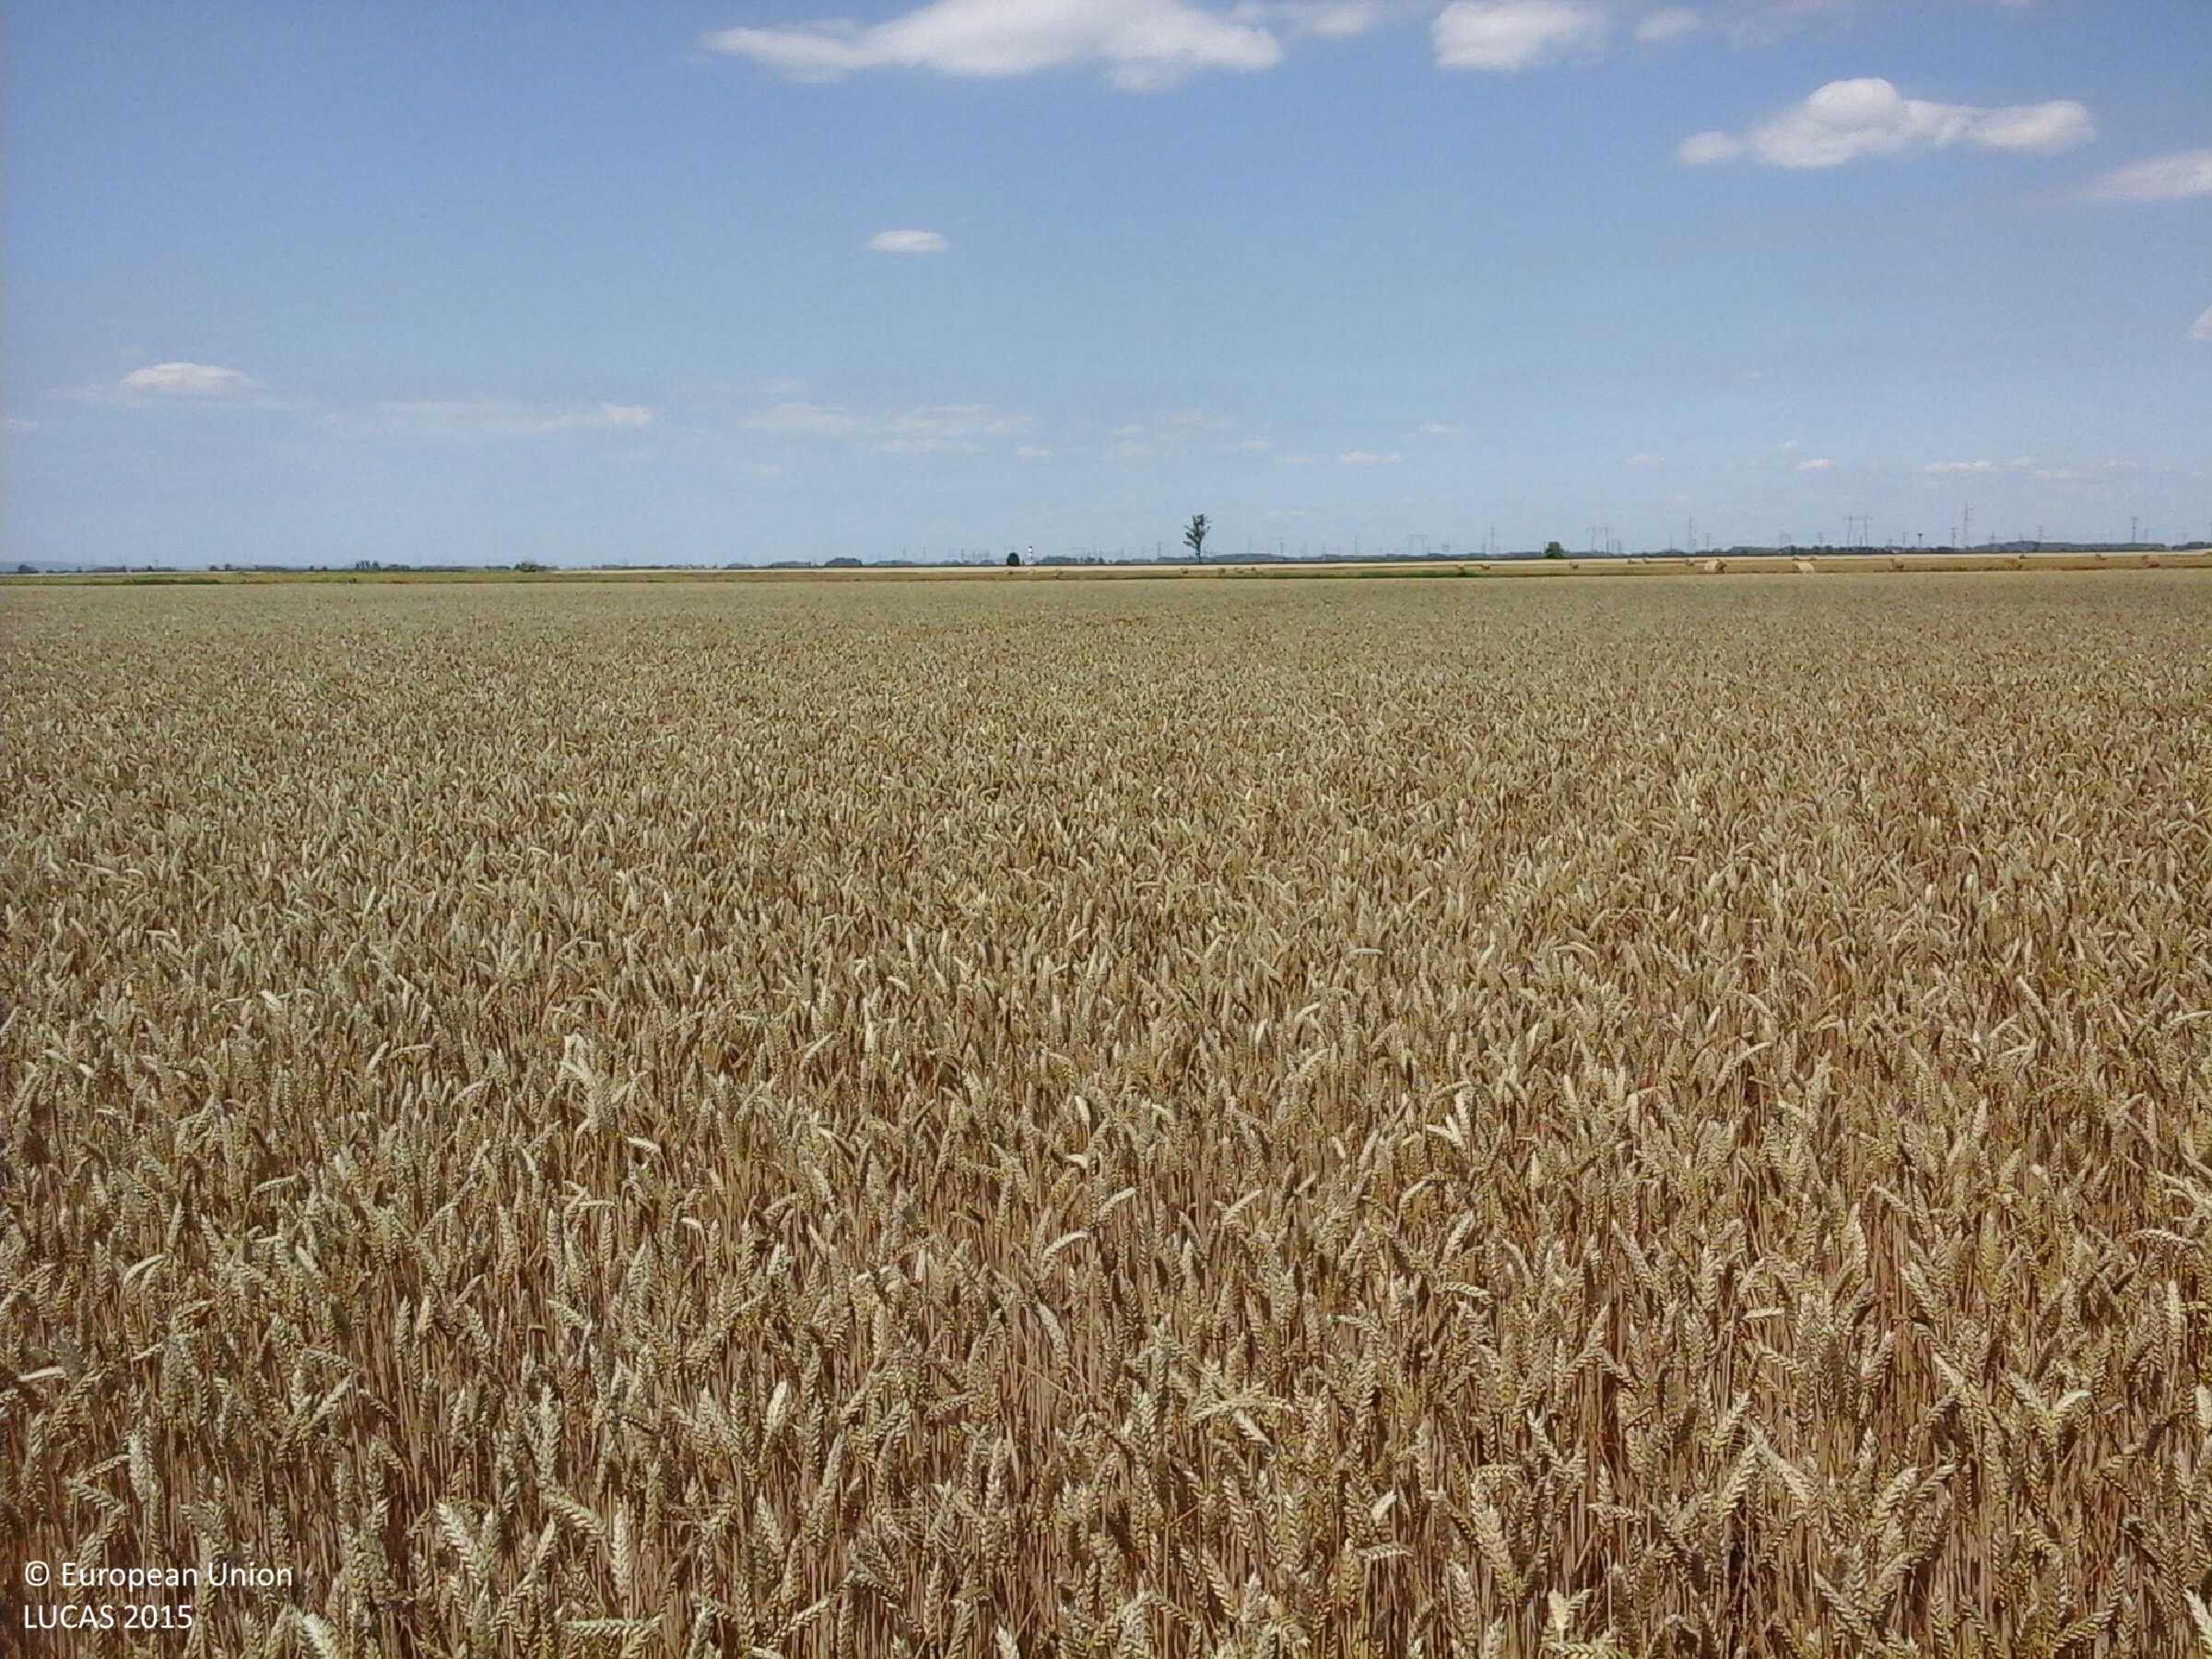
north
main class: Cropland
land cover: Common wheat
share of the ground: > 75 %
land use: Agriculture (excluding fallow land and kitchen gardens)
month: July
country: HU
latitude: 47.8900
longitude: 20.9918
